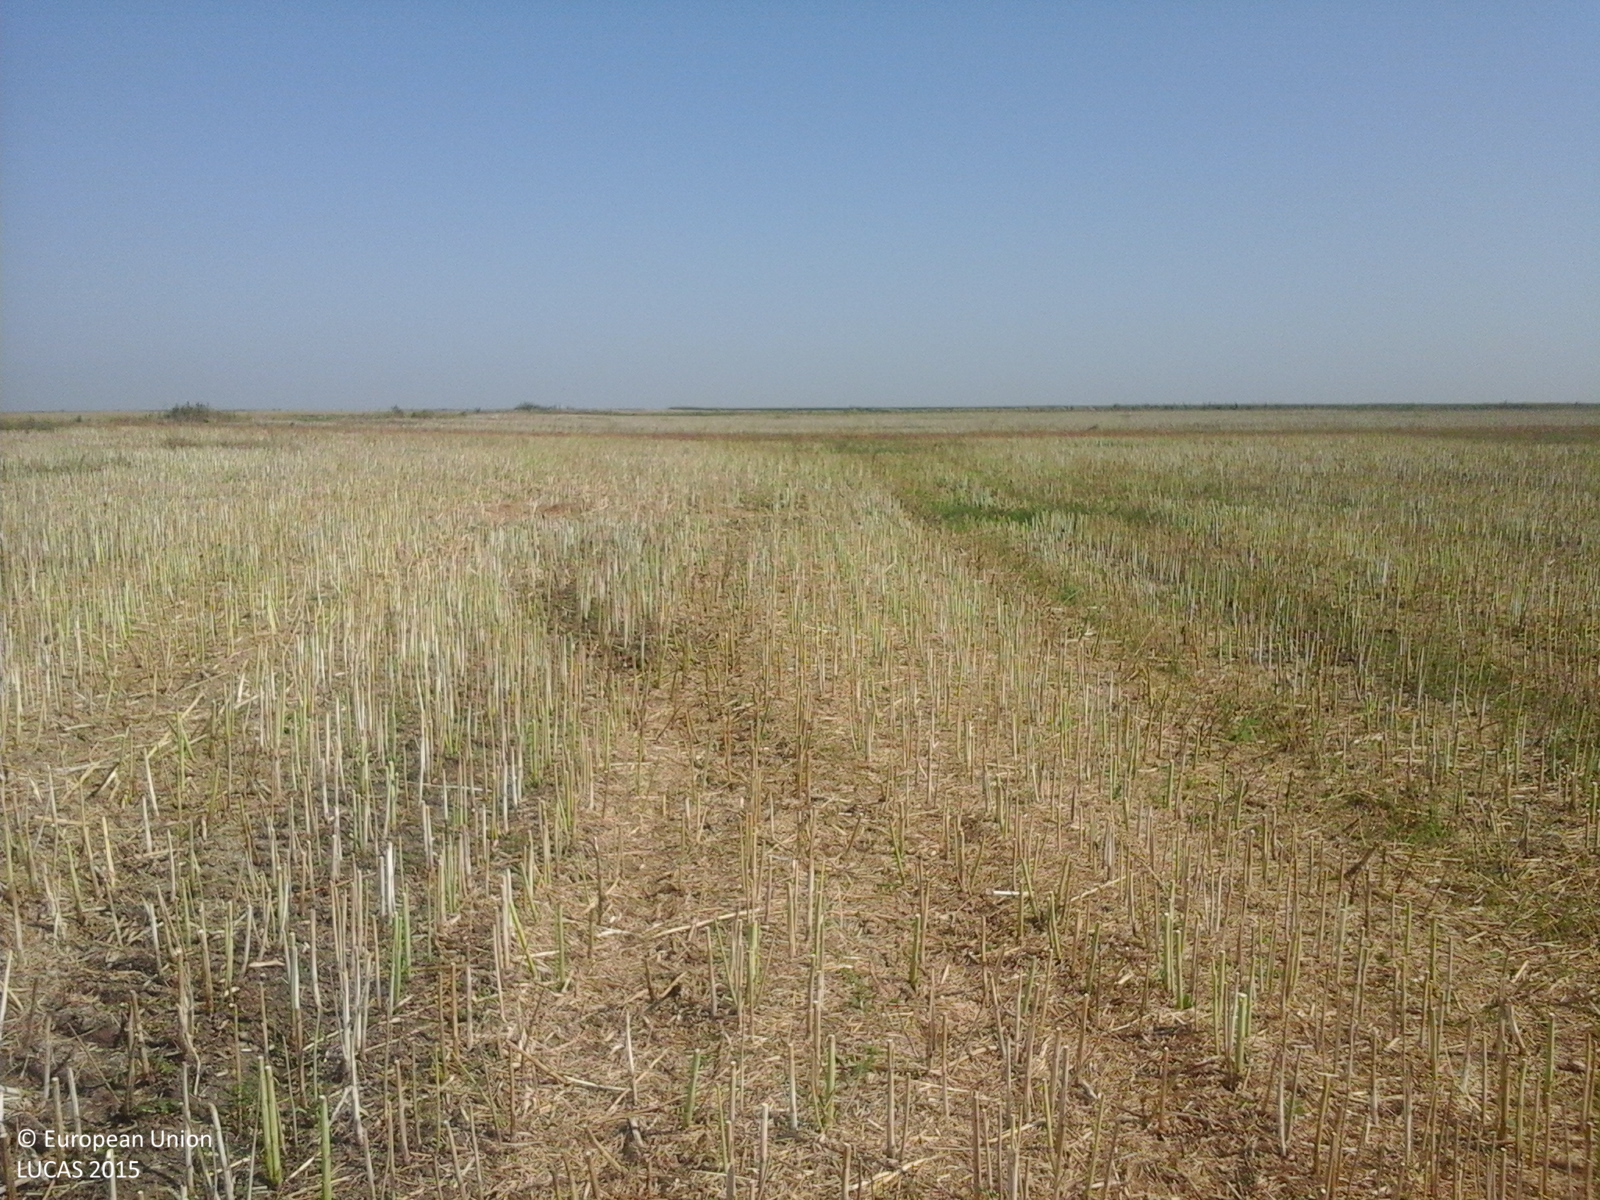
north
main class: Cropland
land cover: Rape and turnip rape
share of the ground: < 10 %
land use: Agriculture (excluding fallow land and kitchen gardens)
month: July
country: RO
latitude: 44.0778
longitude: 24.7444
